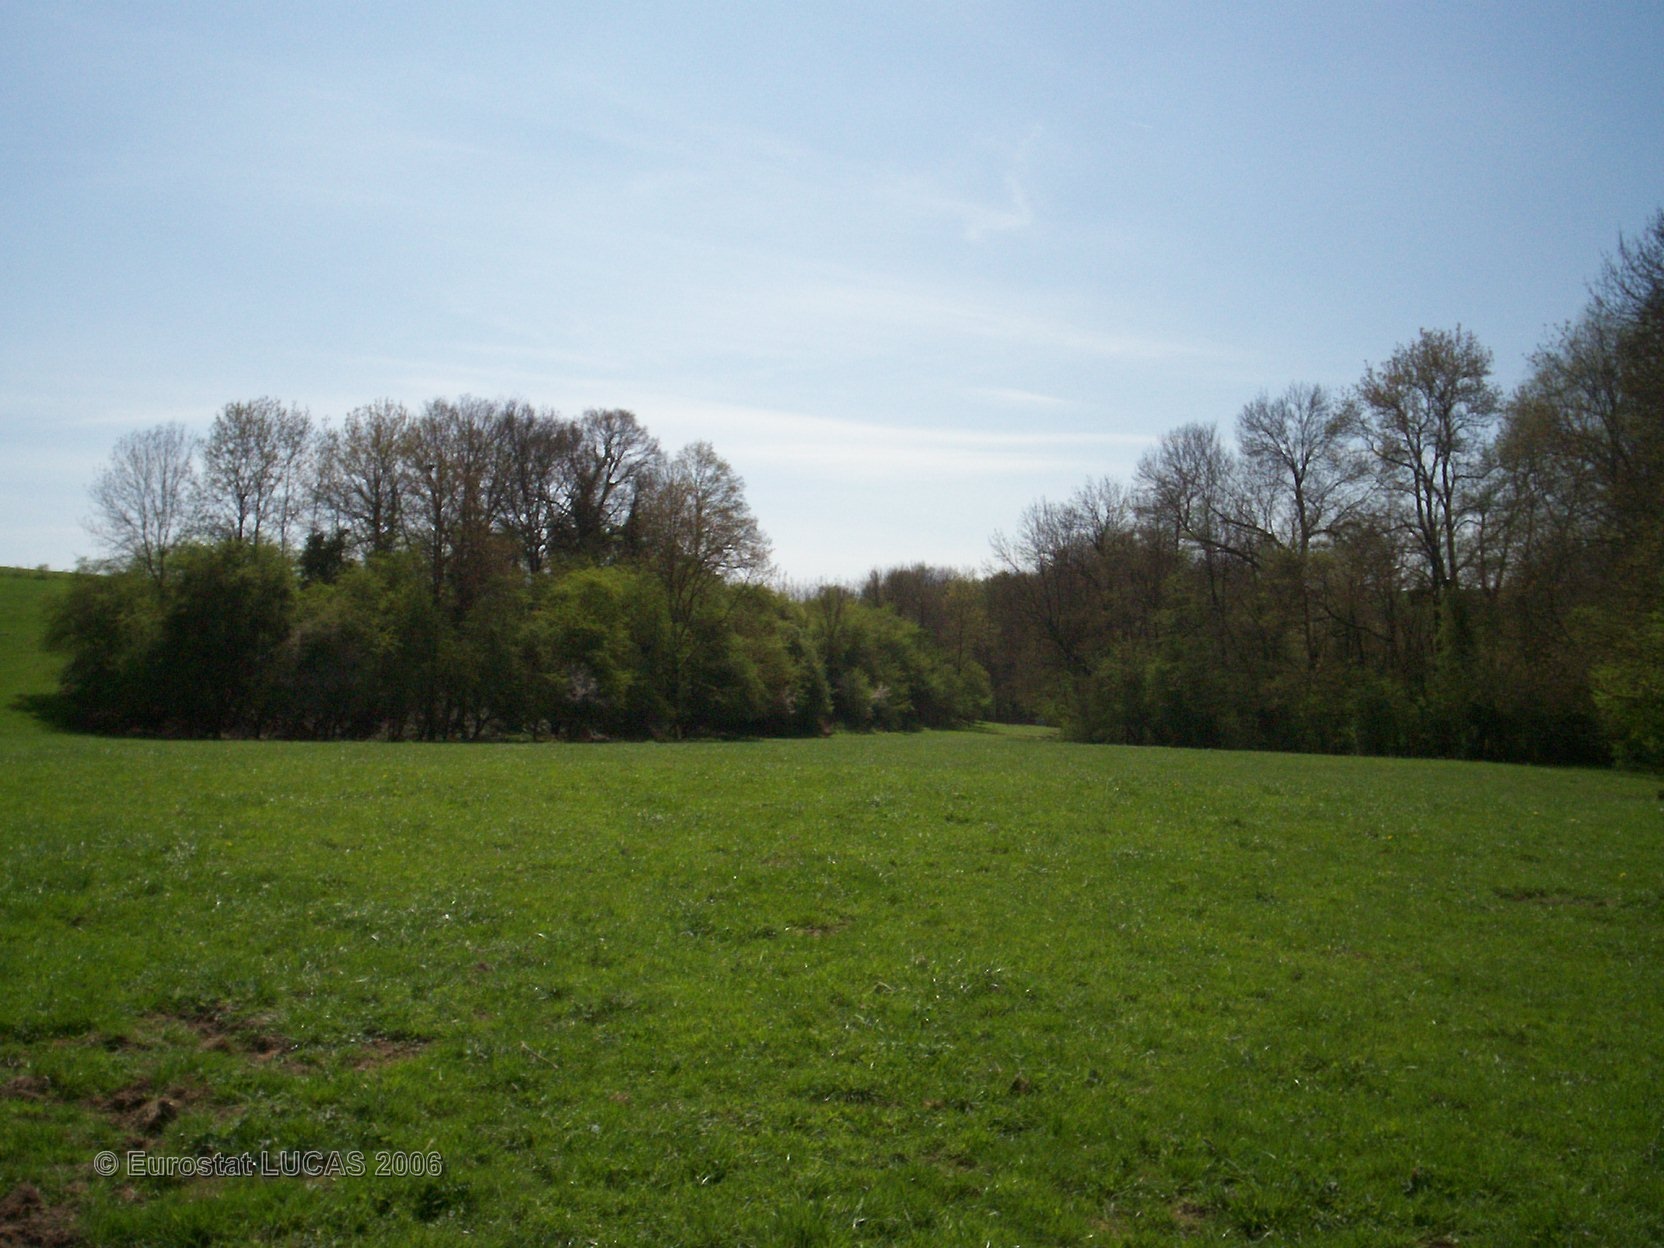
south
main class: Grassland
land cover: Grassland without tree/shrub cover
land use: Agriculture (excluding fallow land and kitchen gardens)
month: April
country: FR
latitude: 49.6466
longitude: 4.3312
